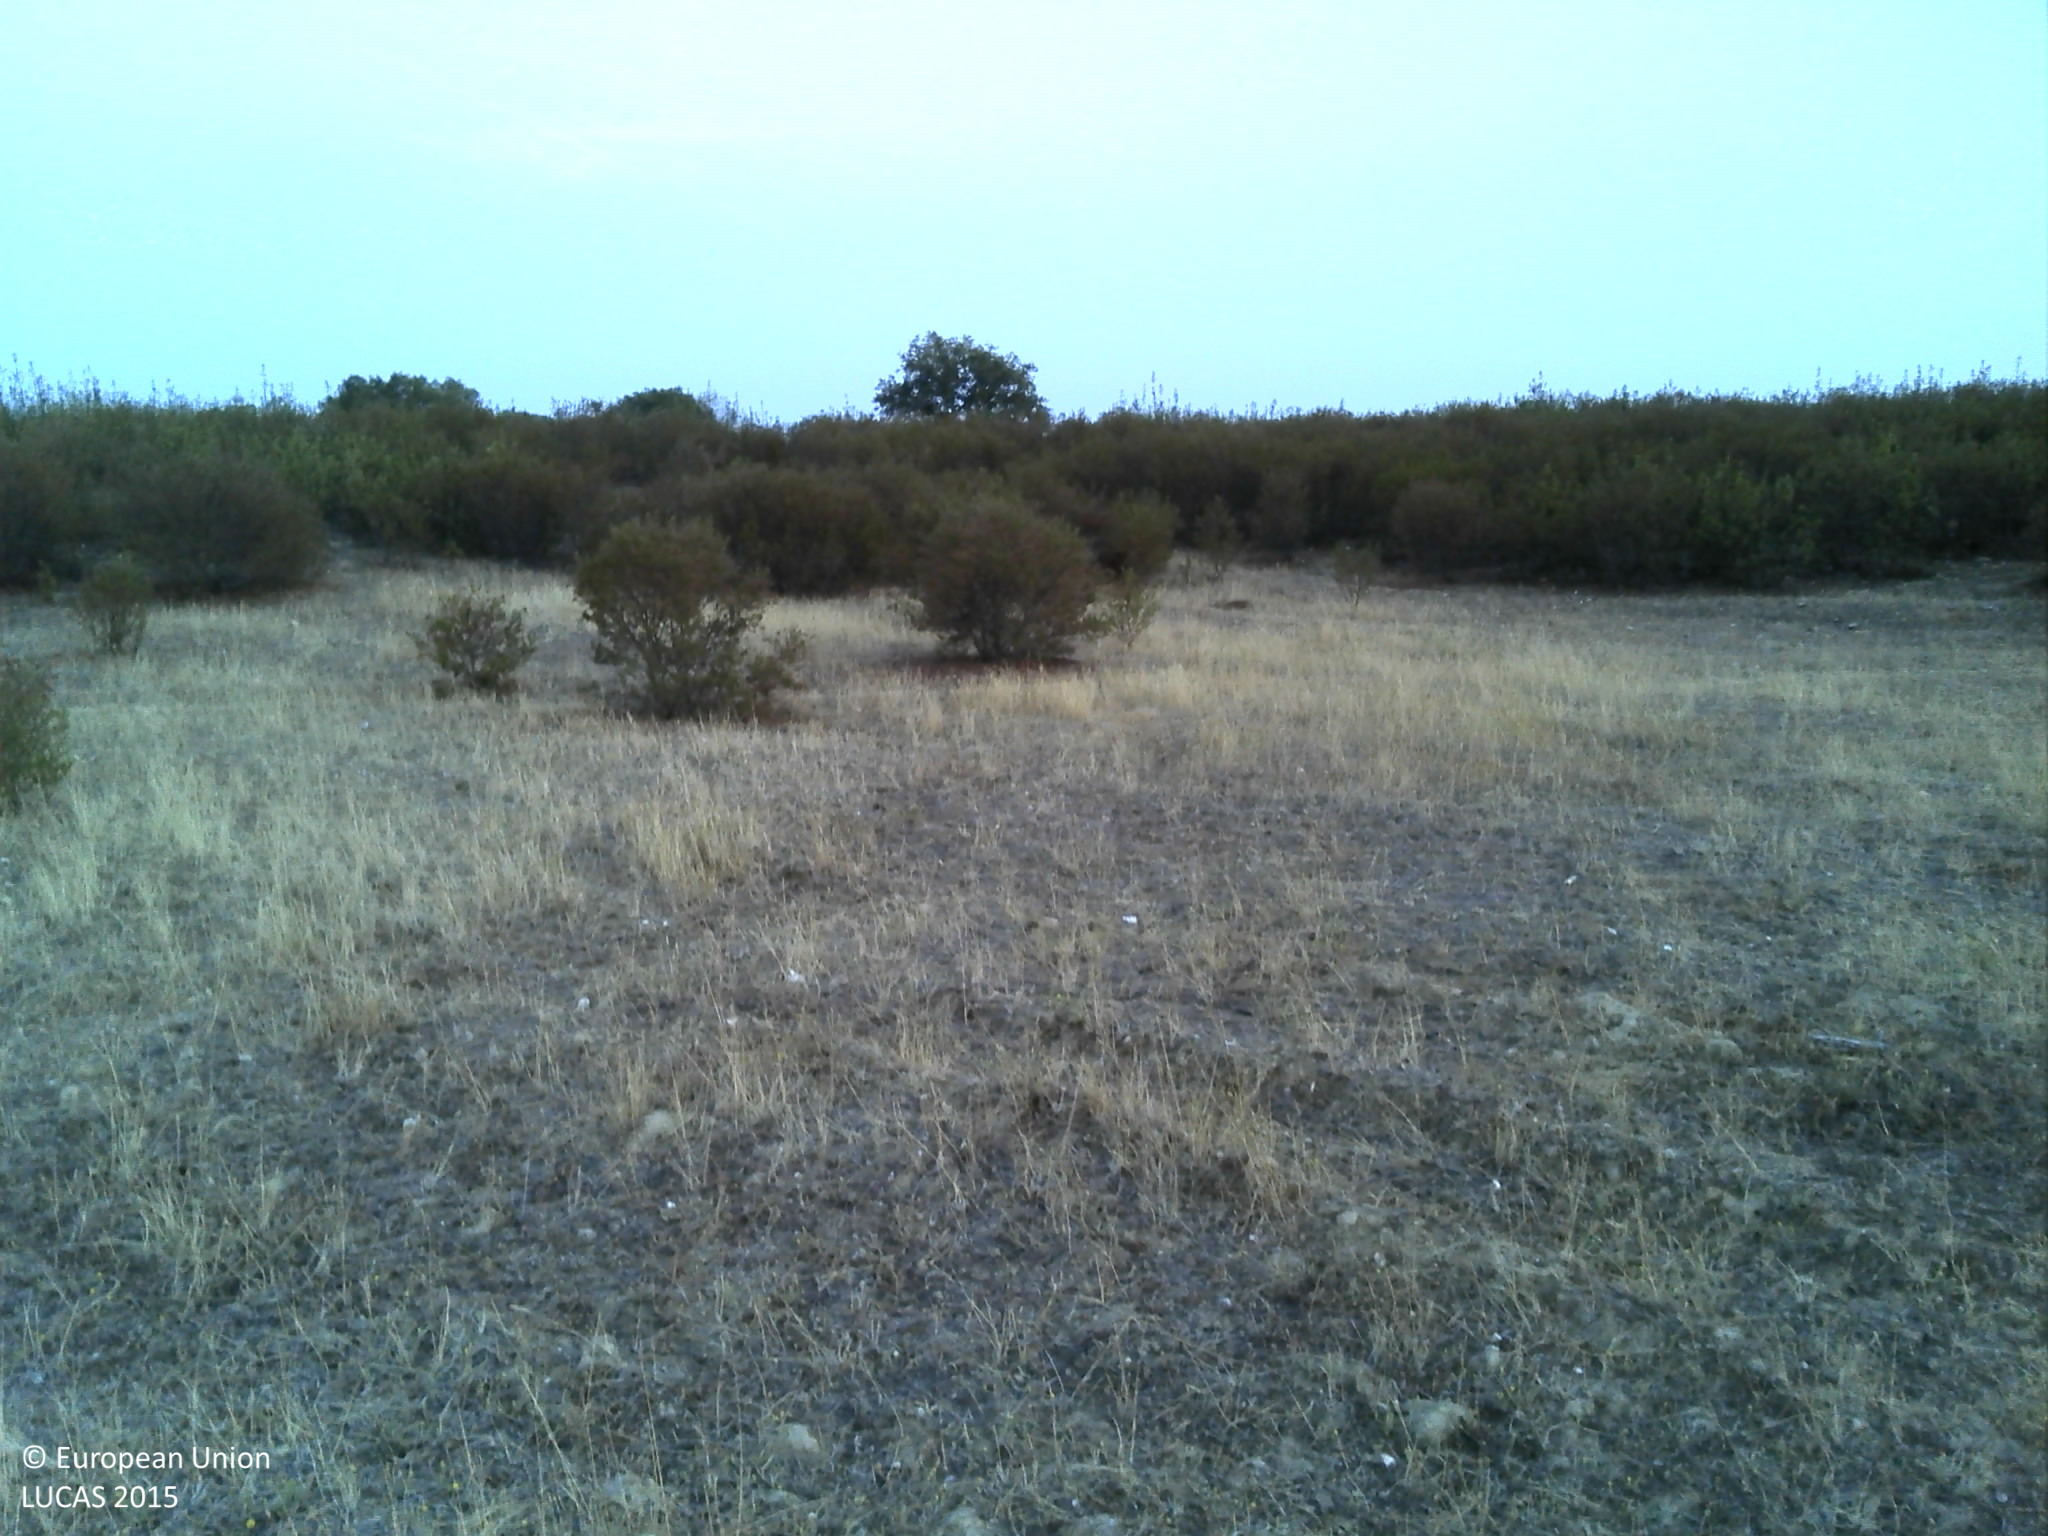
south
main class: Grassland
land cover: Grassland without tree/shrub cover
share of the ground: 10 - 25 %
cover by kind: unconsolidated bare surface 75 %, herbaceous plants 25 %
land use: Agriculture (excluding fallow land and kitchen gardens)
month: July
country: PT
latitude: 37.6146
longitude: -7.8626
